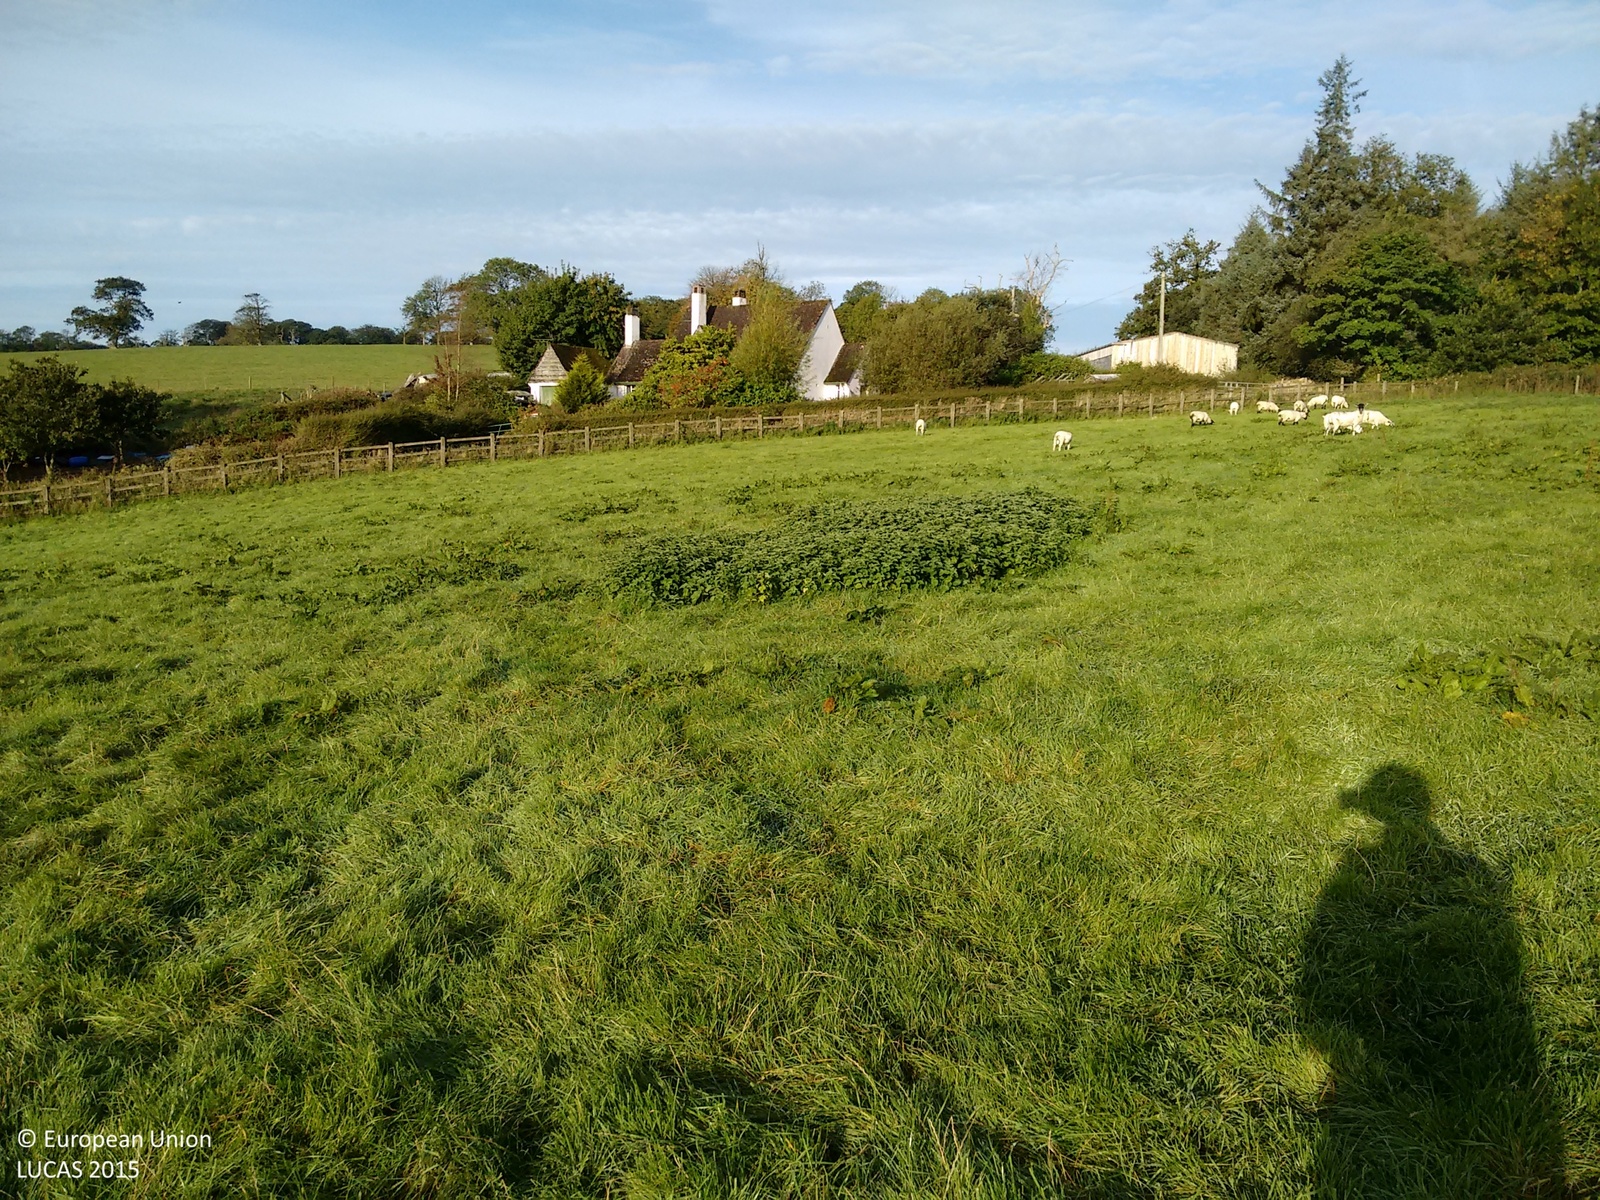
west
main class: Grassland
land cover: Grassland without tree/shrub cover
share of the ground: > 75 %
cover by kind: herbaceous plants 100 %
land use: Agriculture (excluding fallow land and kitchen gardens)
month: September
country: GB
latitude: 50.7610
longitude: -4.1173
